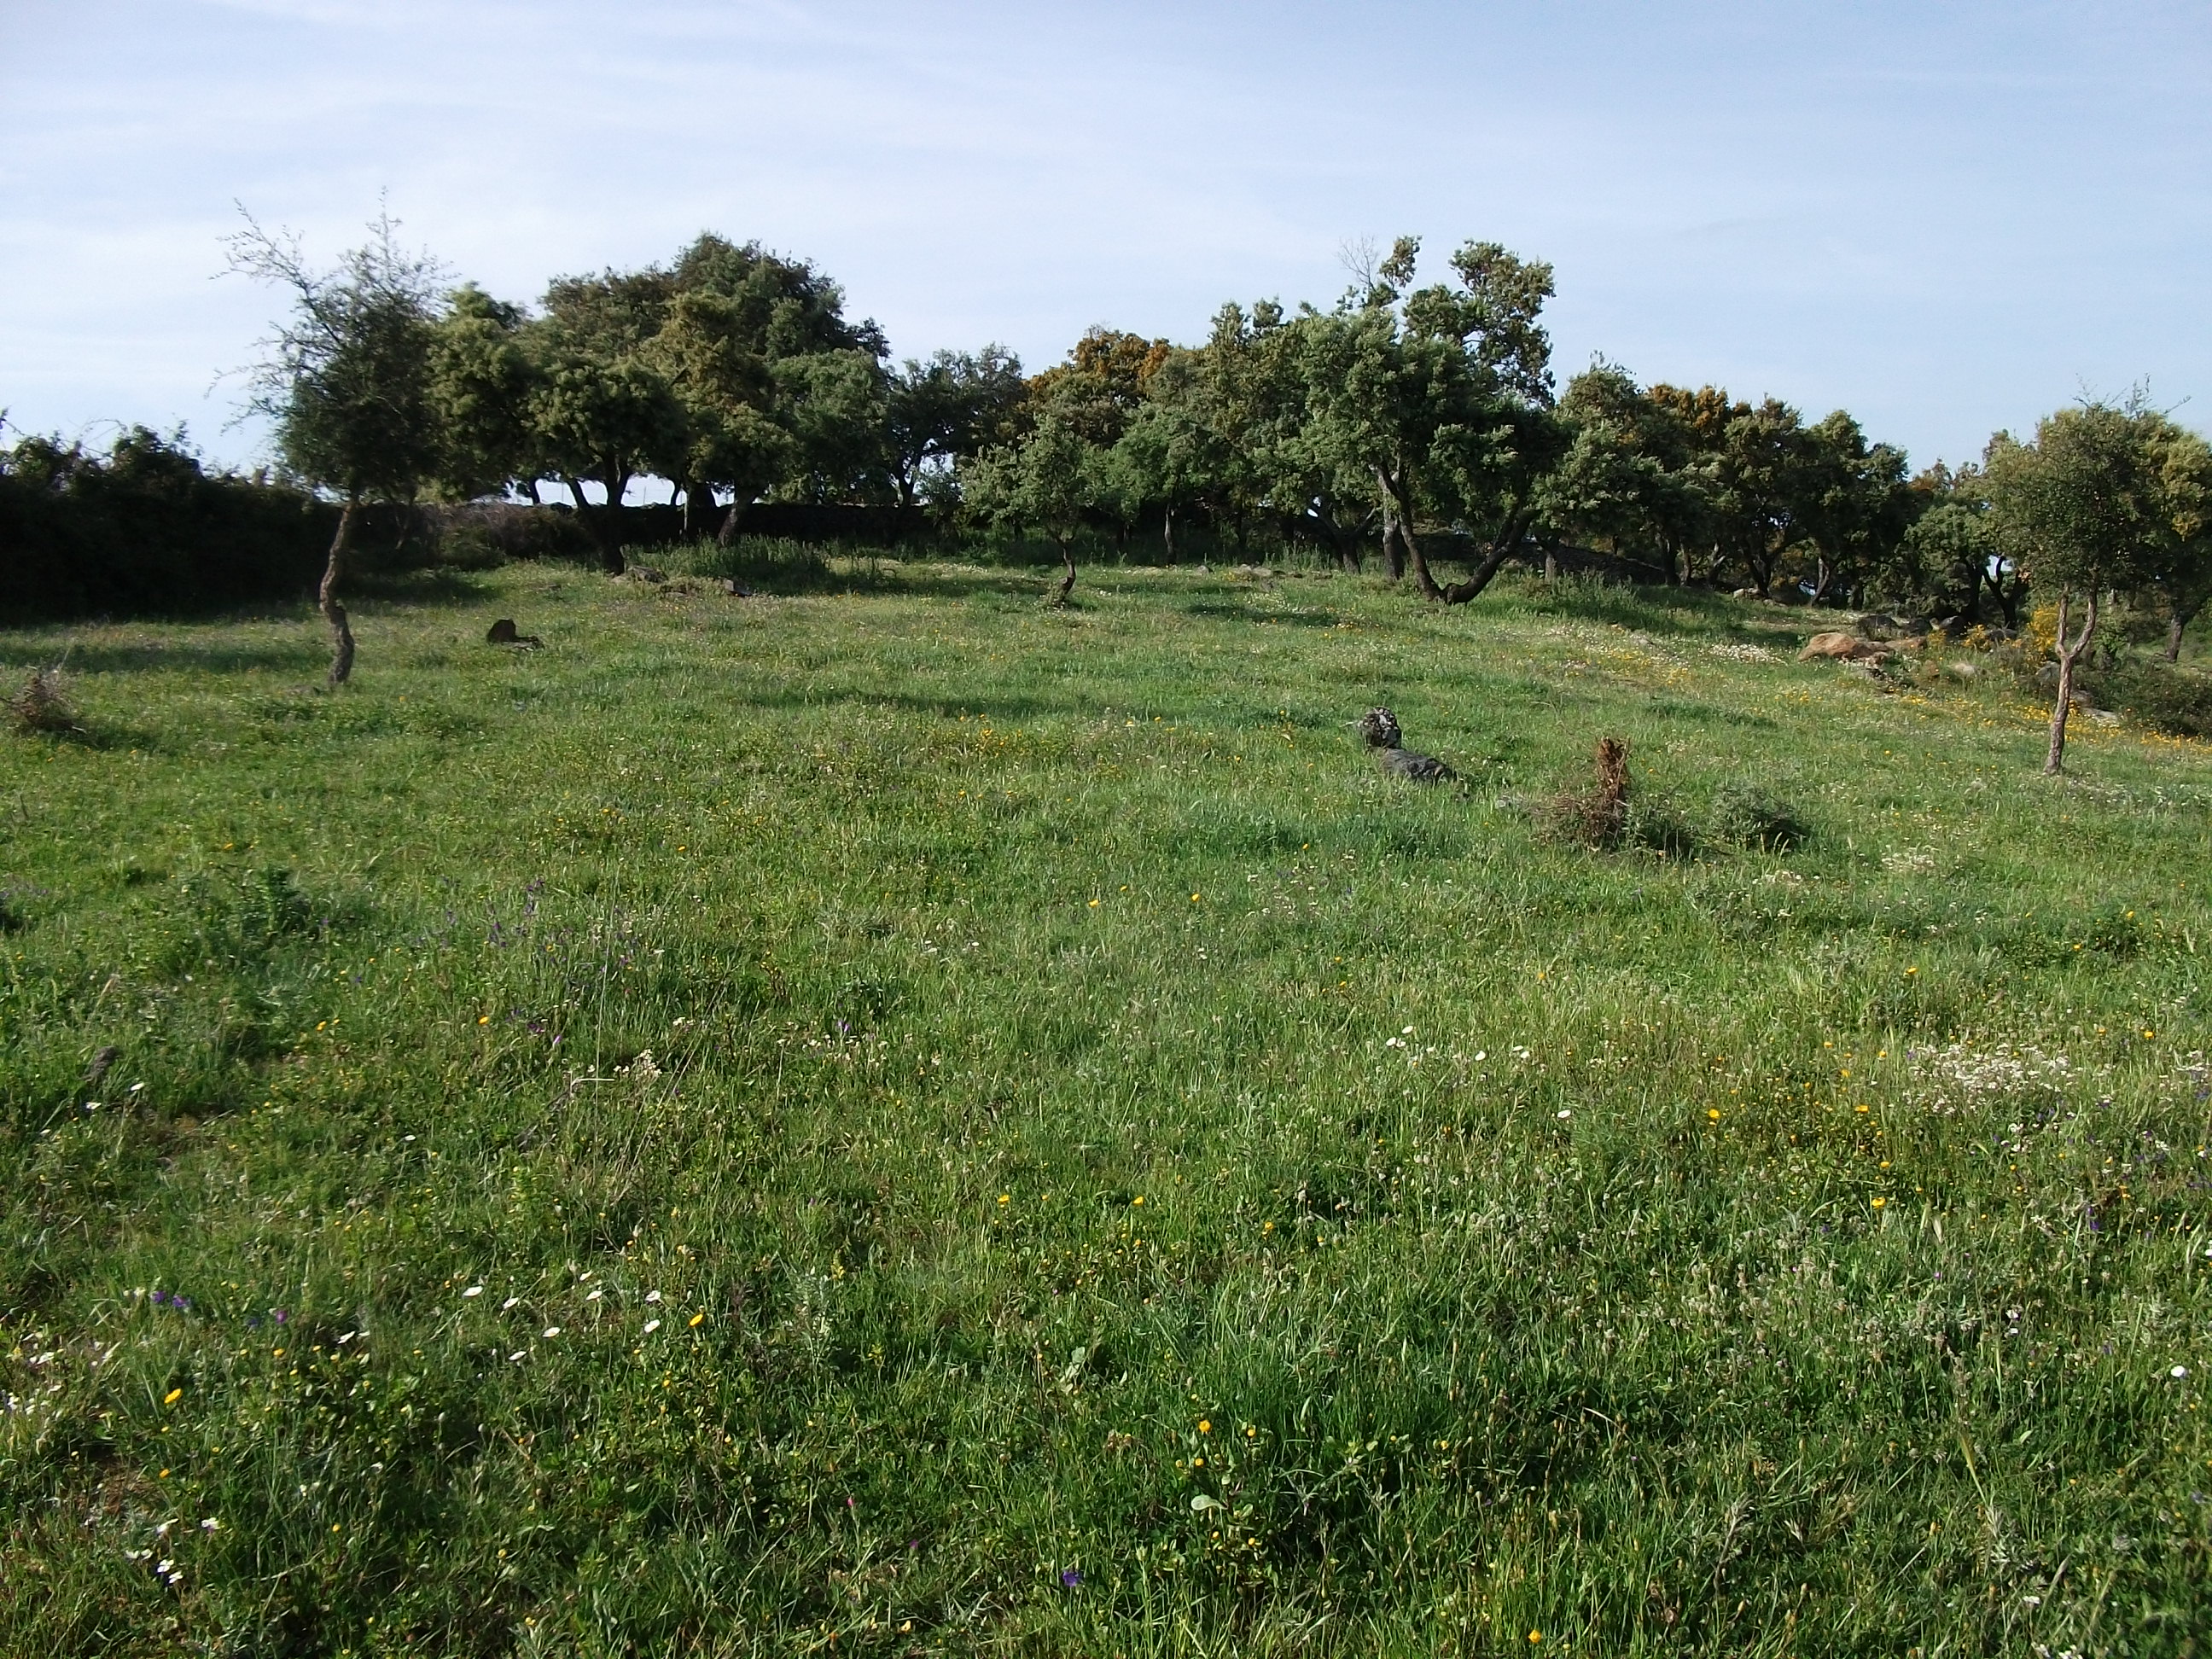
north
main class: Grassland
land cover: Spontaneously vegetated surfaces
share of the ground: > 75 %
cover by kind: herbaceous plants 100 %
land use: Agriculture (excluding fallow land and kitchen gardens)
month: April
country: ES
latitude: 38.0720
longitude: -6.6803
